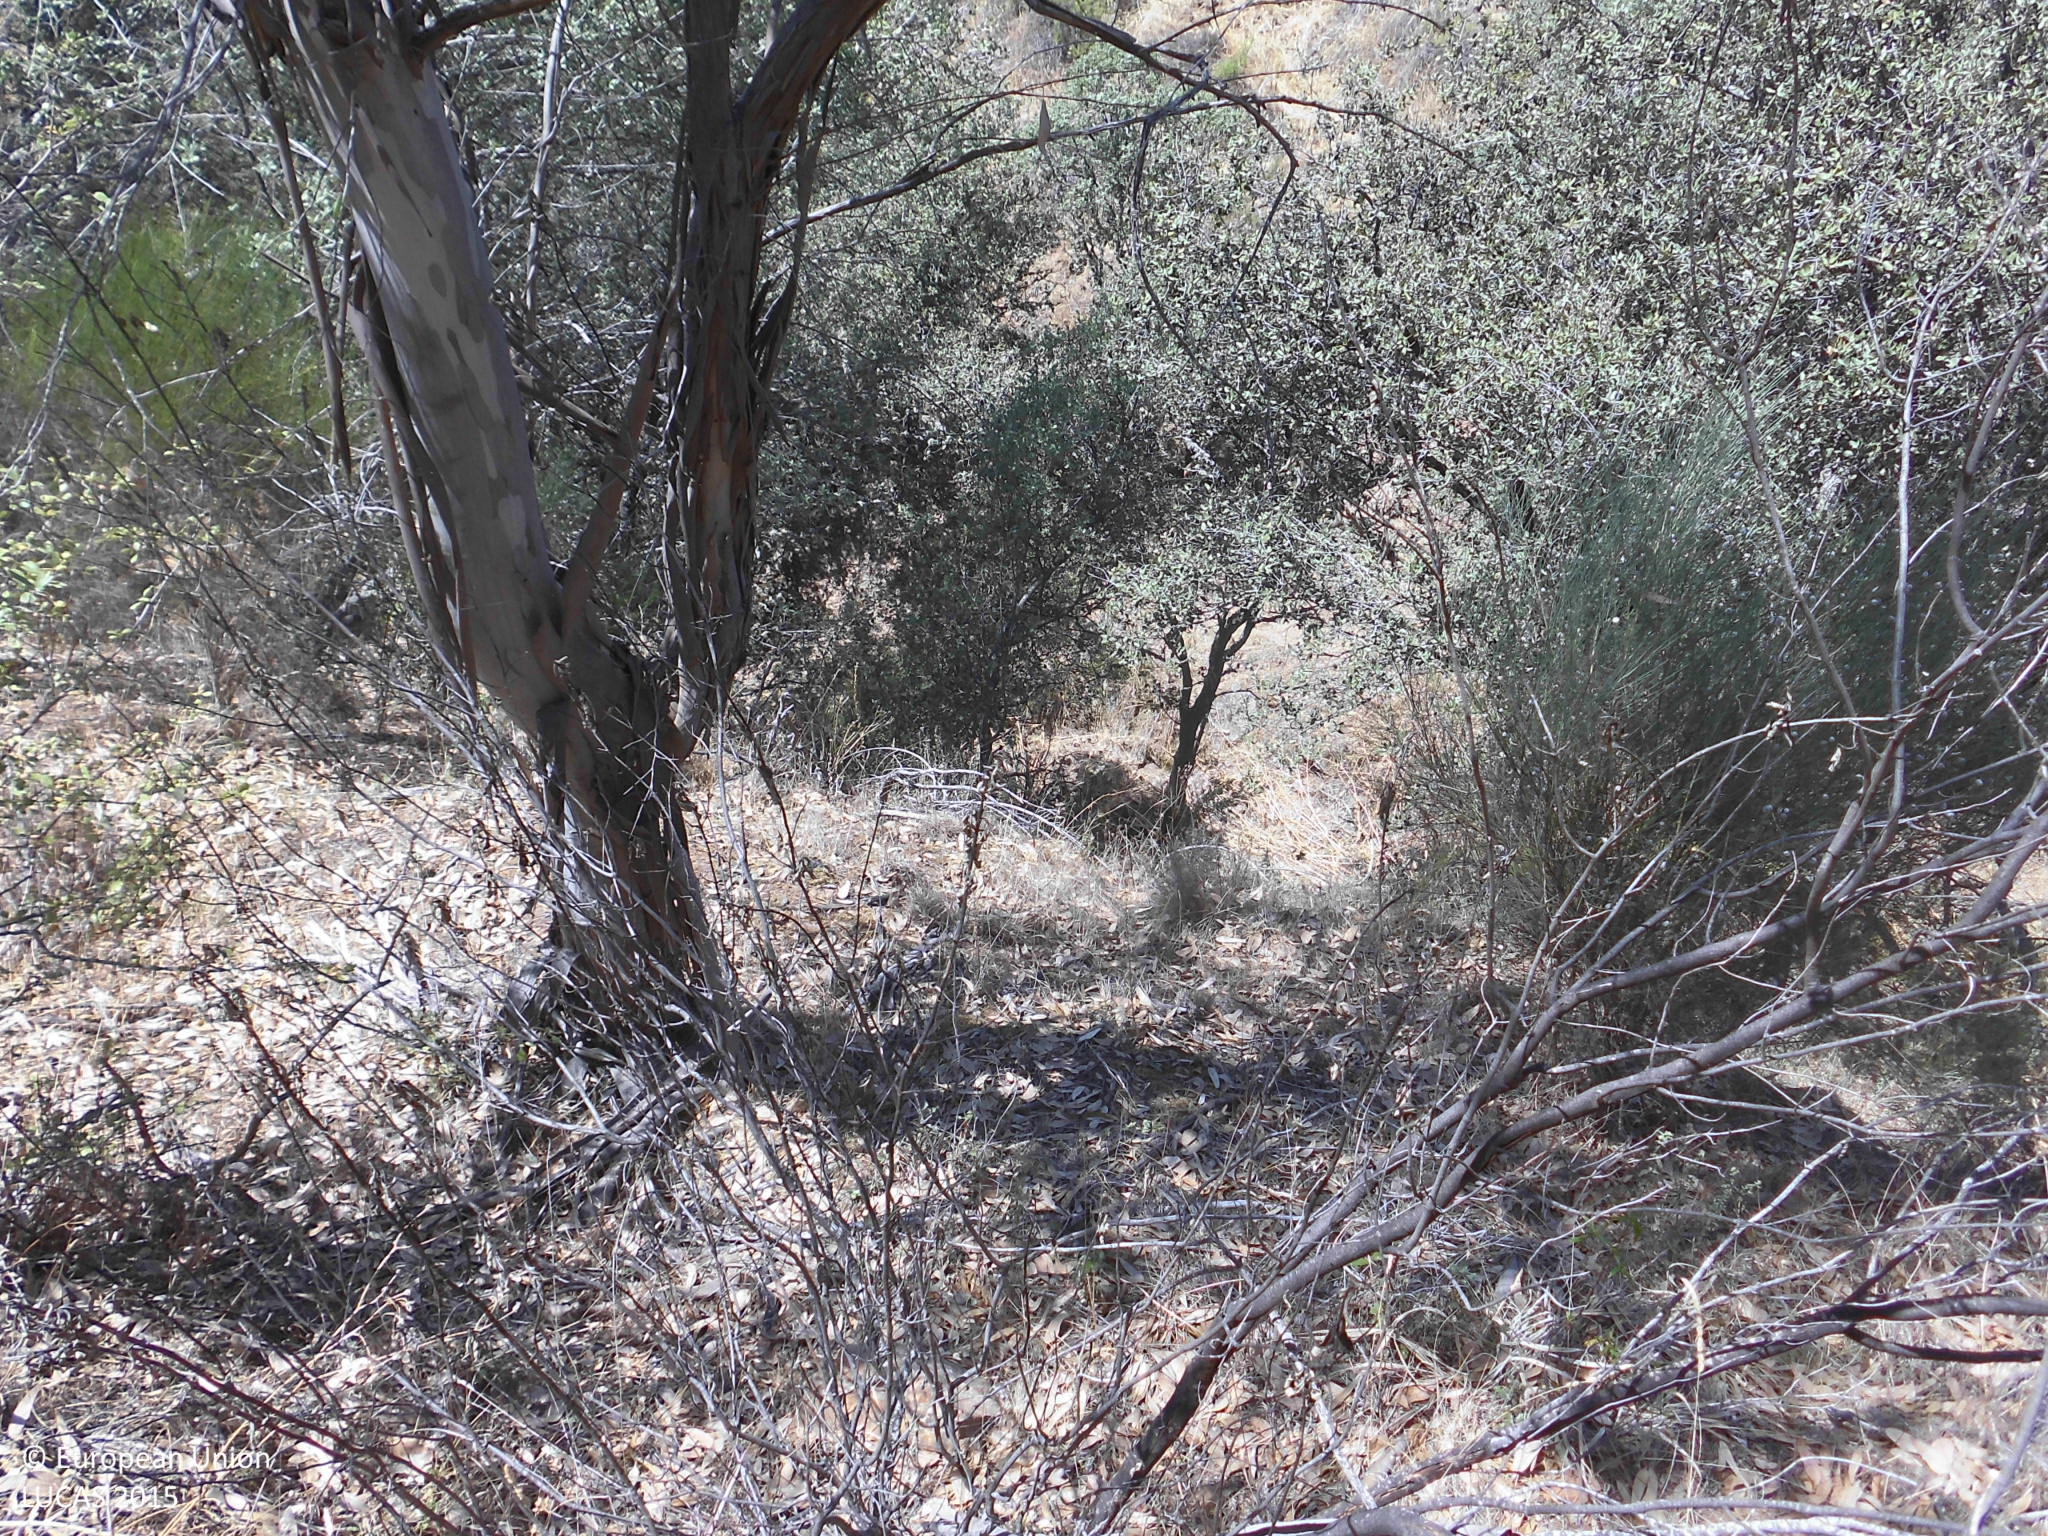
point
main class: Woodland
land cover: Broadleaved woodland
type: exotic forest
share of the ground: 50 - 75 %
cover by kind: broadleaved forest trees 75 %, shrubs 20 %, herbaceous plants 5 %
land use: Forestry
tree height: > 5 m
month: July
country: ES
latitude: 39.7205
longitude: -5.4179
